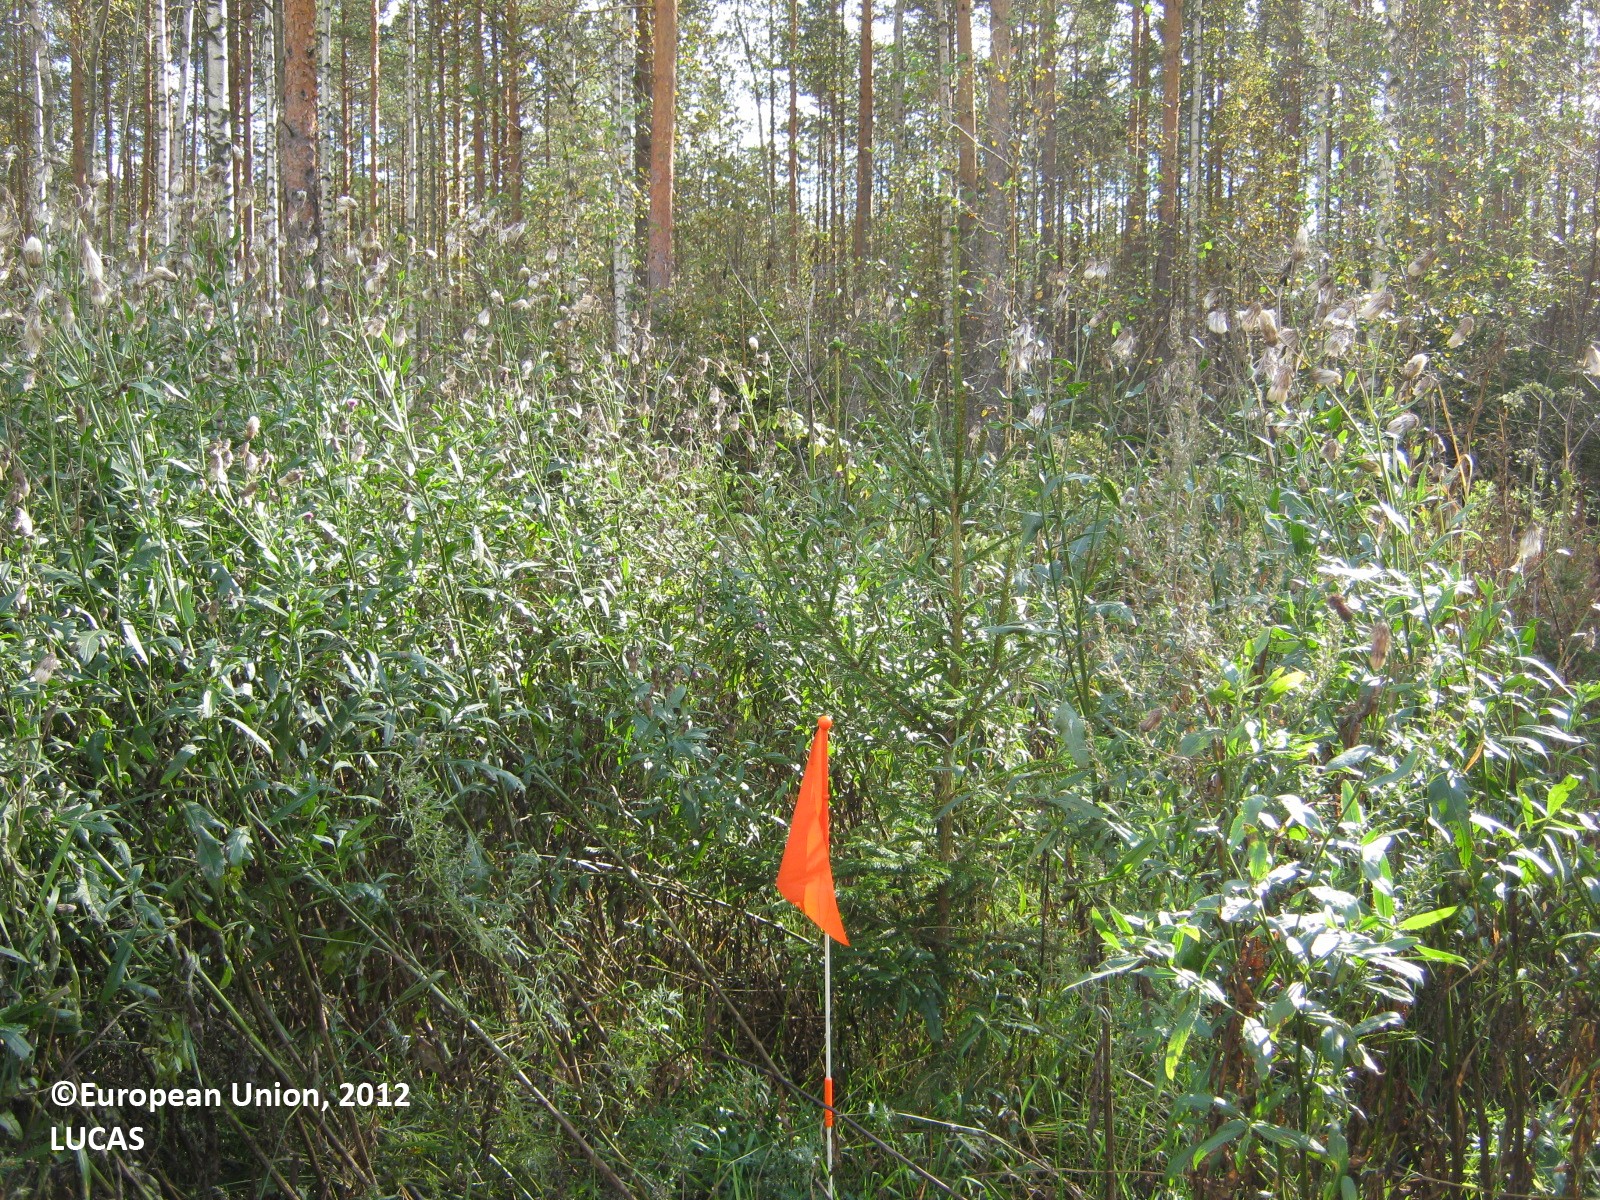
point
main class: Shrubland
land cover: Shrubland with sparse tree cover
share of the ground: > 75 %
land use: Semi-natural and natural areas not in use
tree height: < 5 m
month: September
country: FI
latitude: 60.8932
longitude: 27.7544
